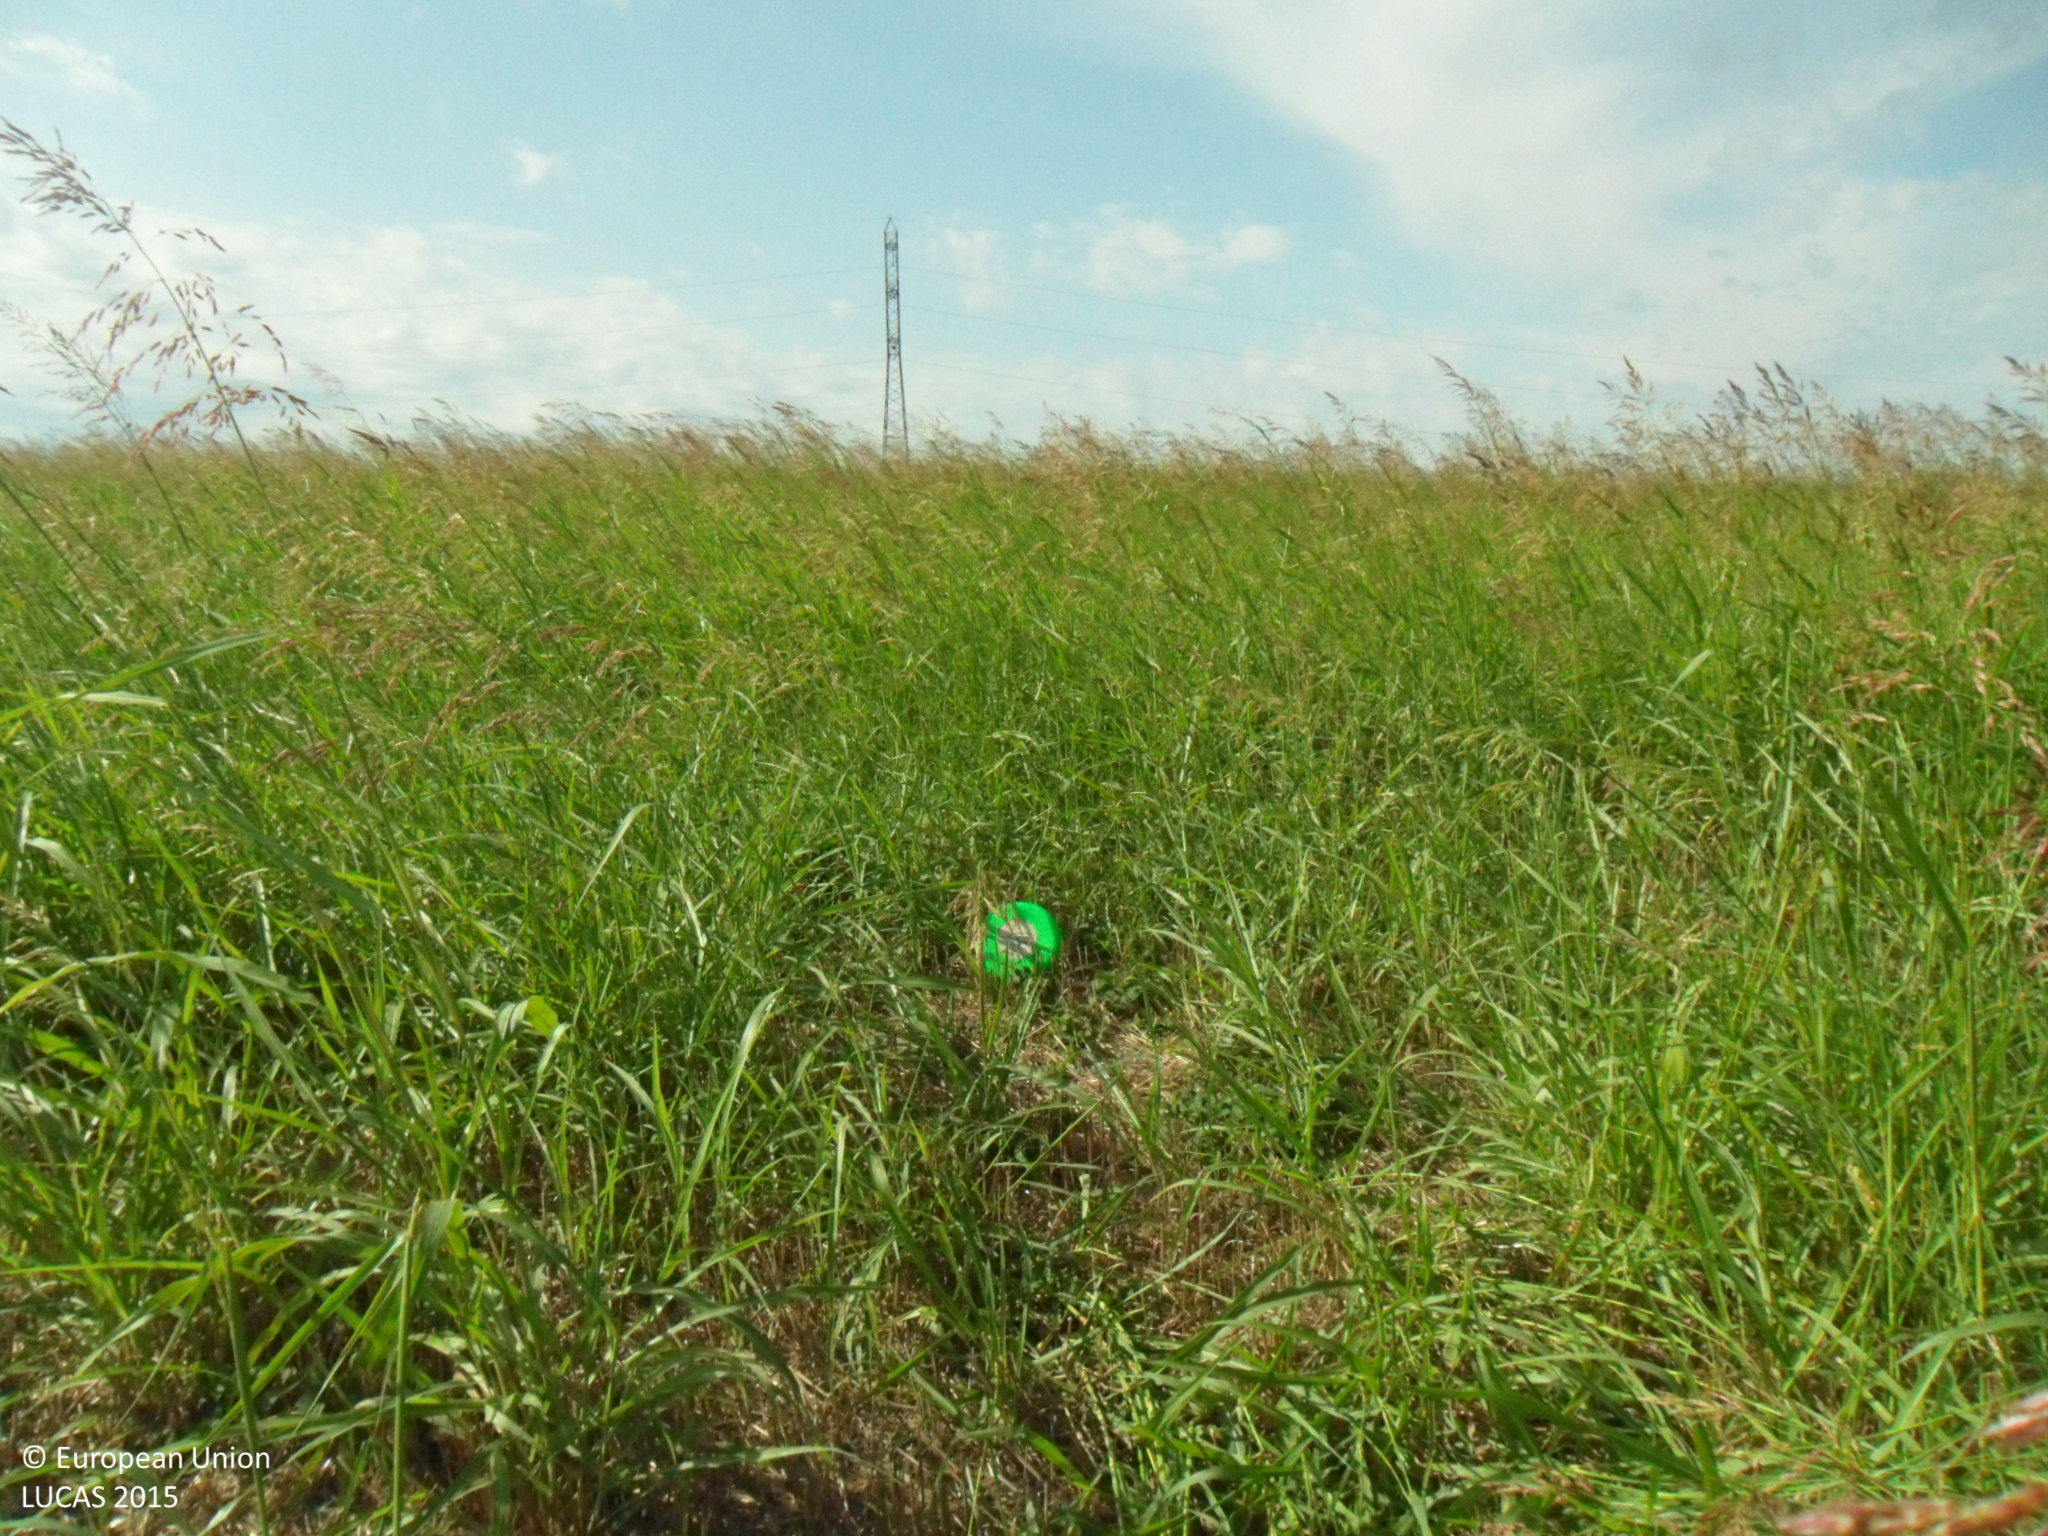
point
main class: Cropland
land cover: Common wheat
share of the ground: < 10 %
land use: Agriculture (excluding fallow land and kitchen gardens)
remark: Harvested field
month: September
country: BG
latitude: 43.5899
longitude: 26.2635
